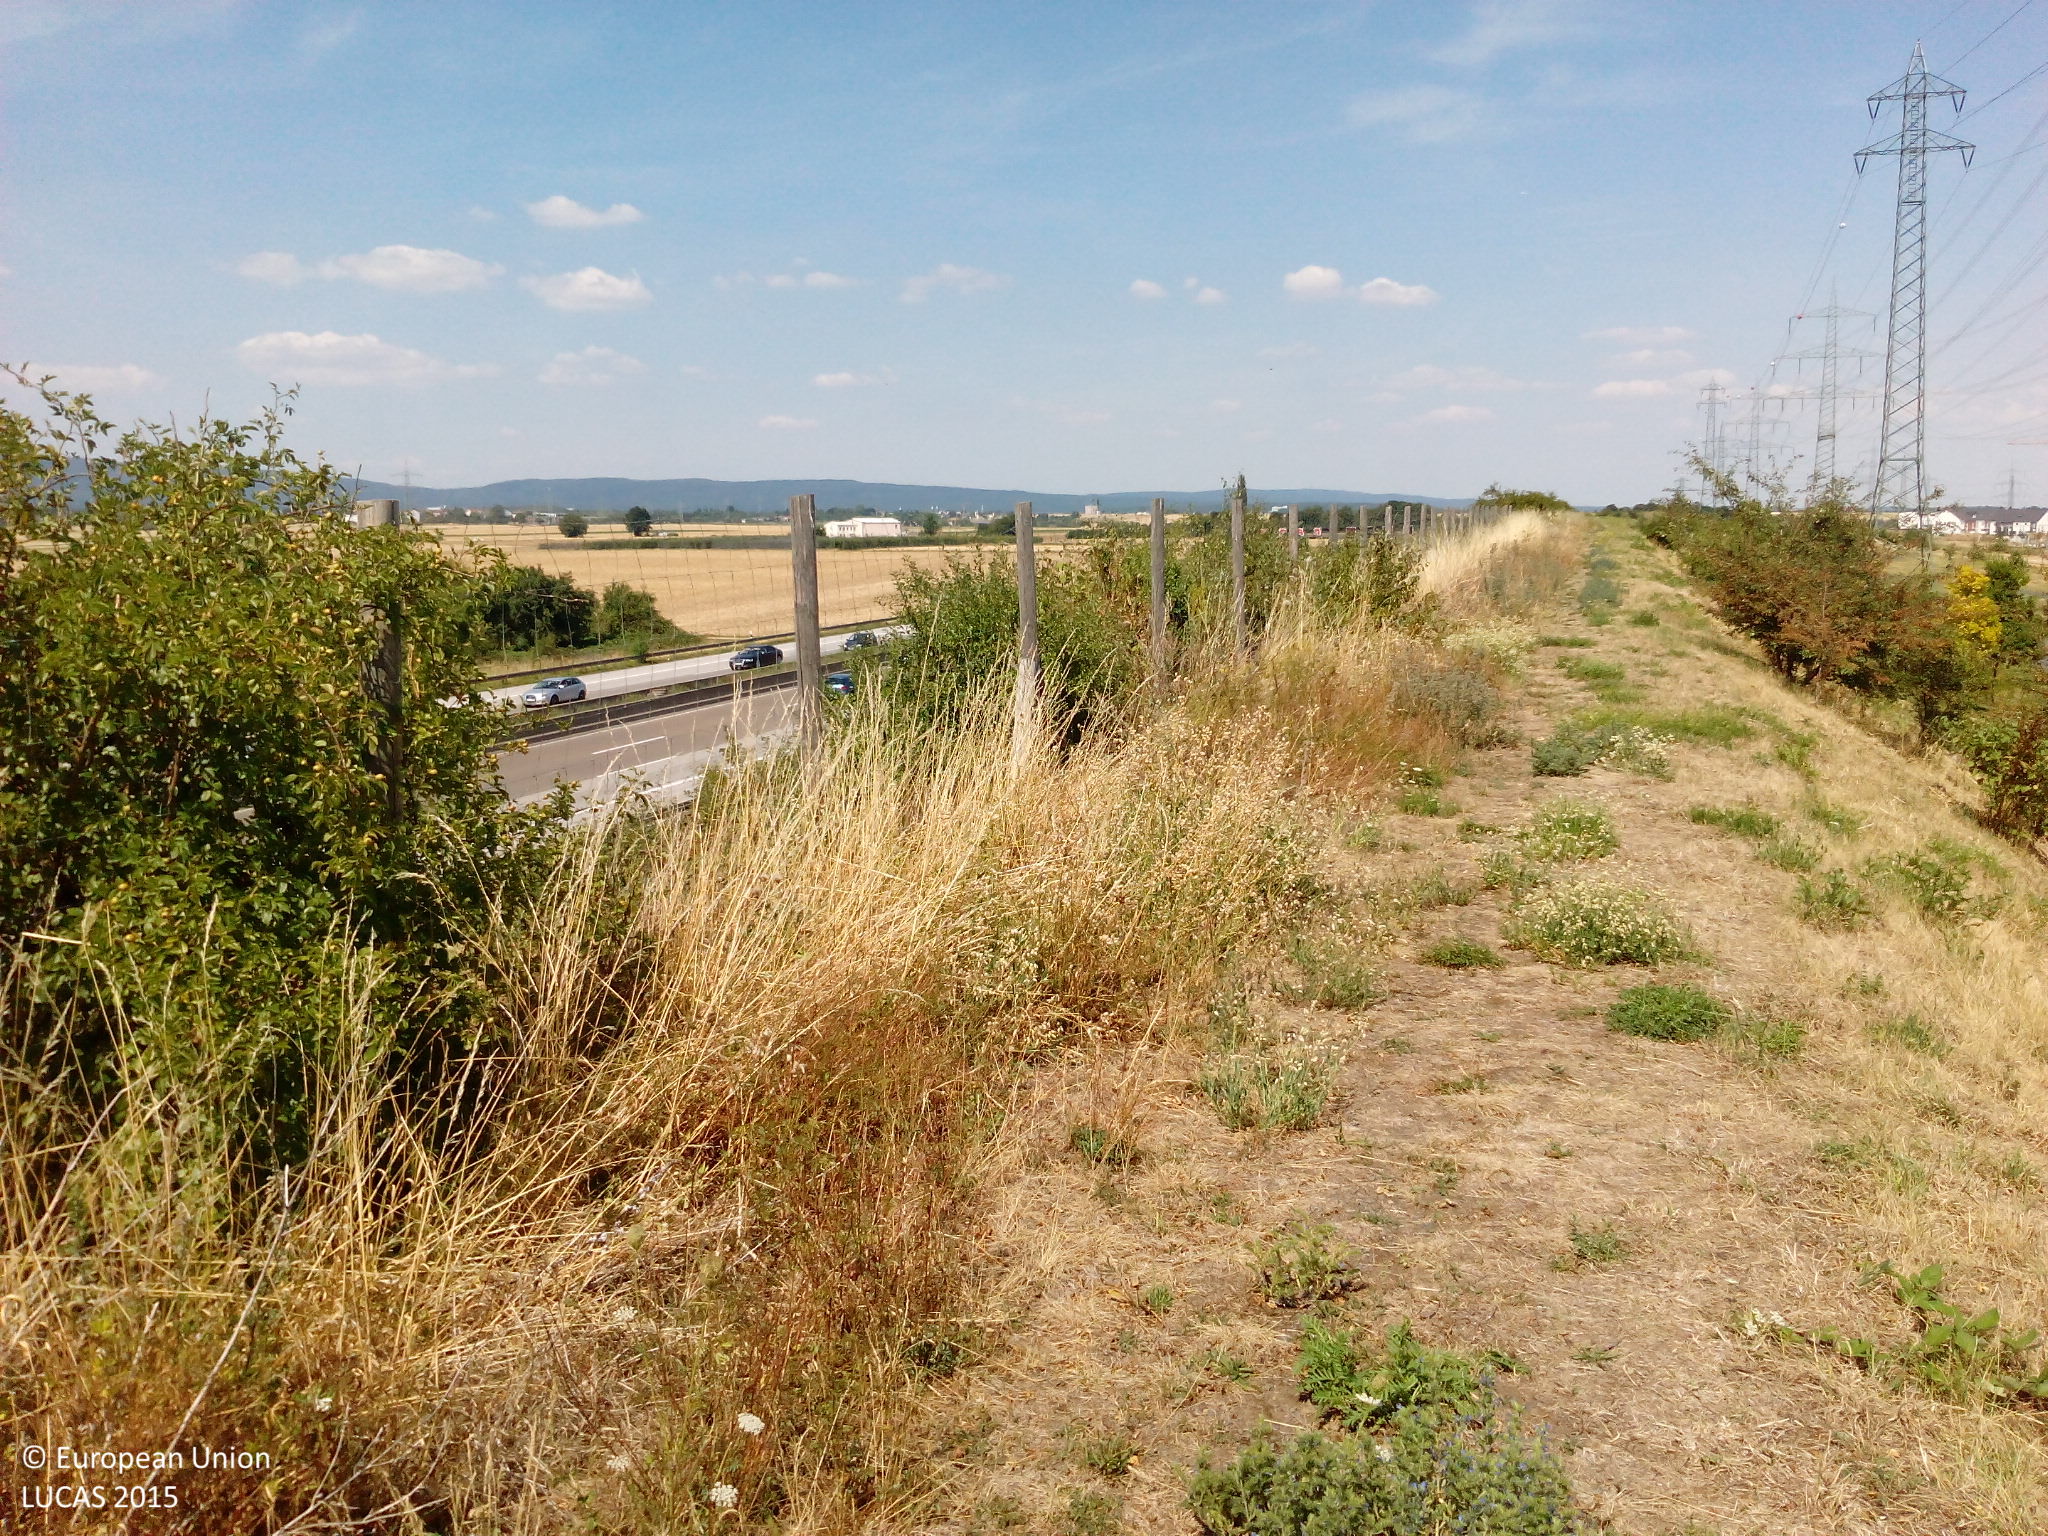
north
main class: Shrubland
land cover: Shrubland without tree cover
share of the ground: > 75 %
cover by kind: herbaceous plants 80 %, shrubs 15 %, unconsolidated bare surface 5 %
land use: Road transport
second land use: Protection infrastructures
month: August
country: DE
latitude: 50.1758
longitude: 8.6141
